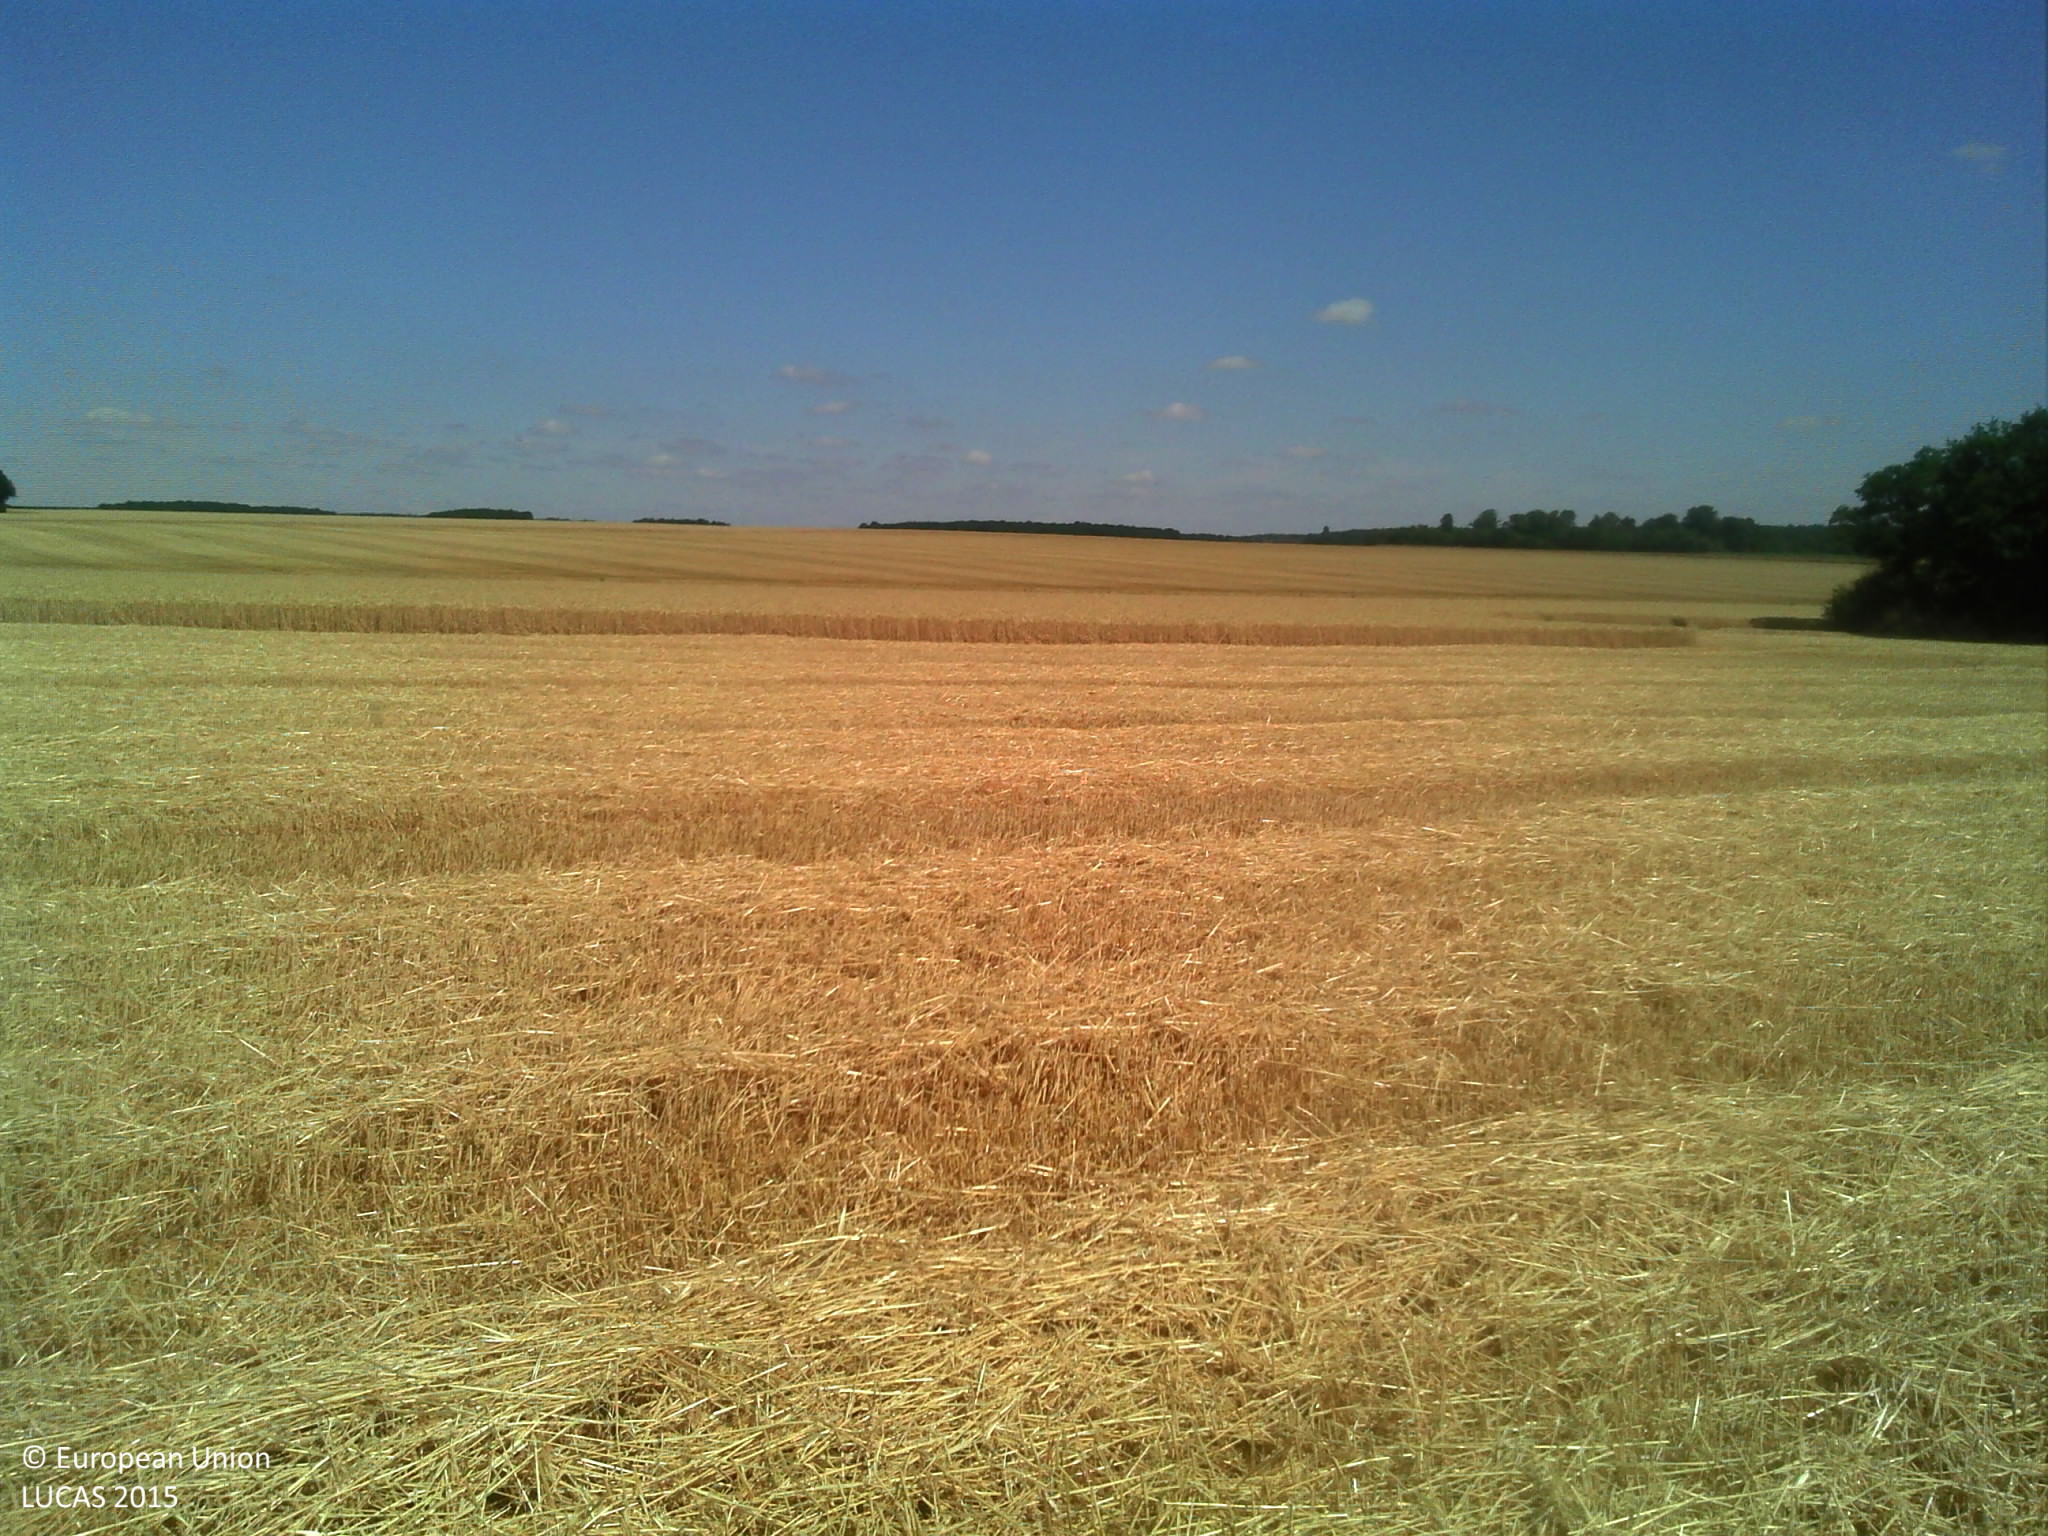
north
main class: Cropland
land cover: Common wheat
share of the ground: > 75 %
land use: Agriculture (excluding fallow land and kitchen gardens)
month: July
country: FR
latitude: 48.1337
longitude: 1.3158
